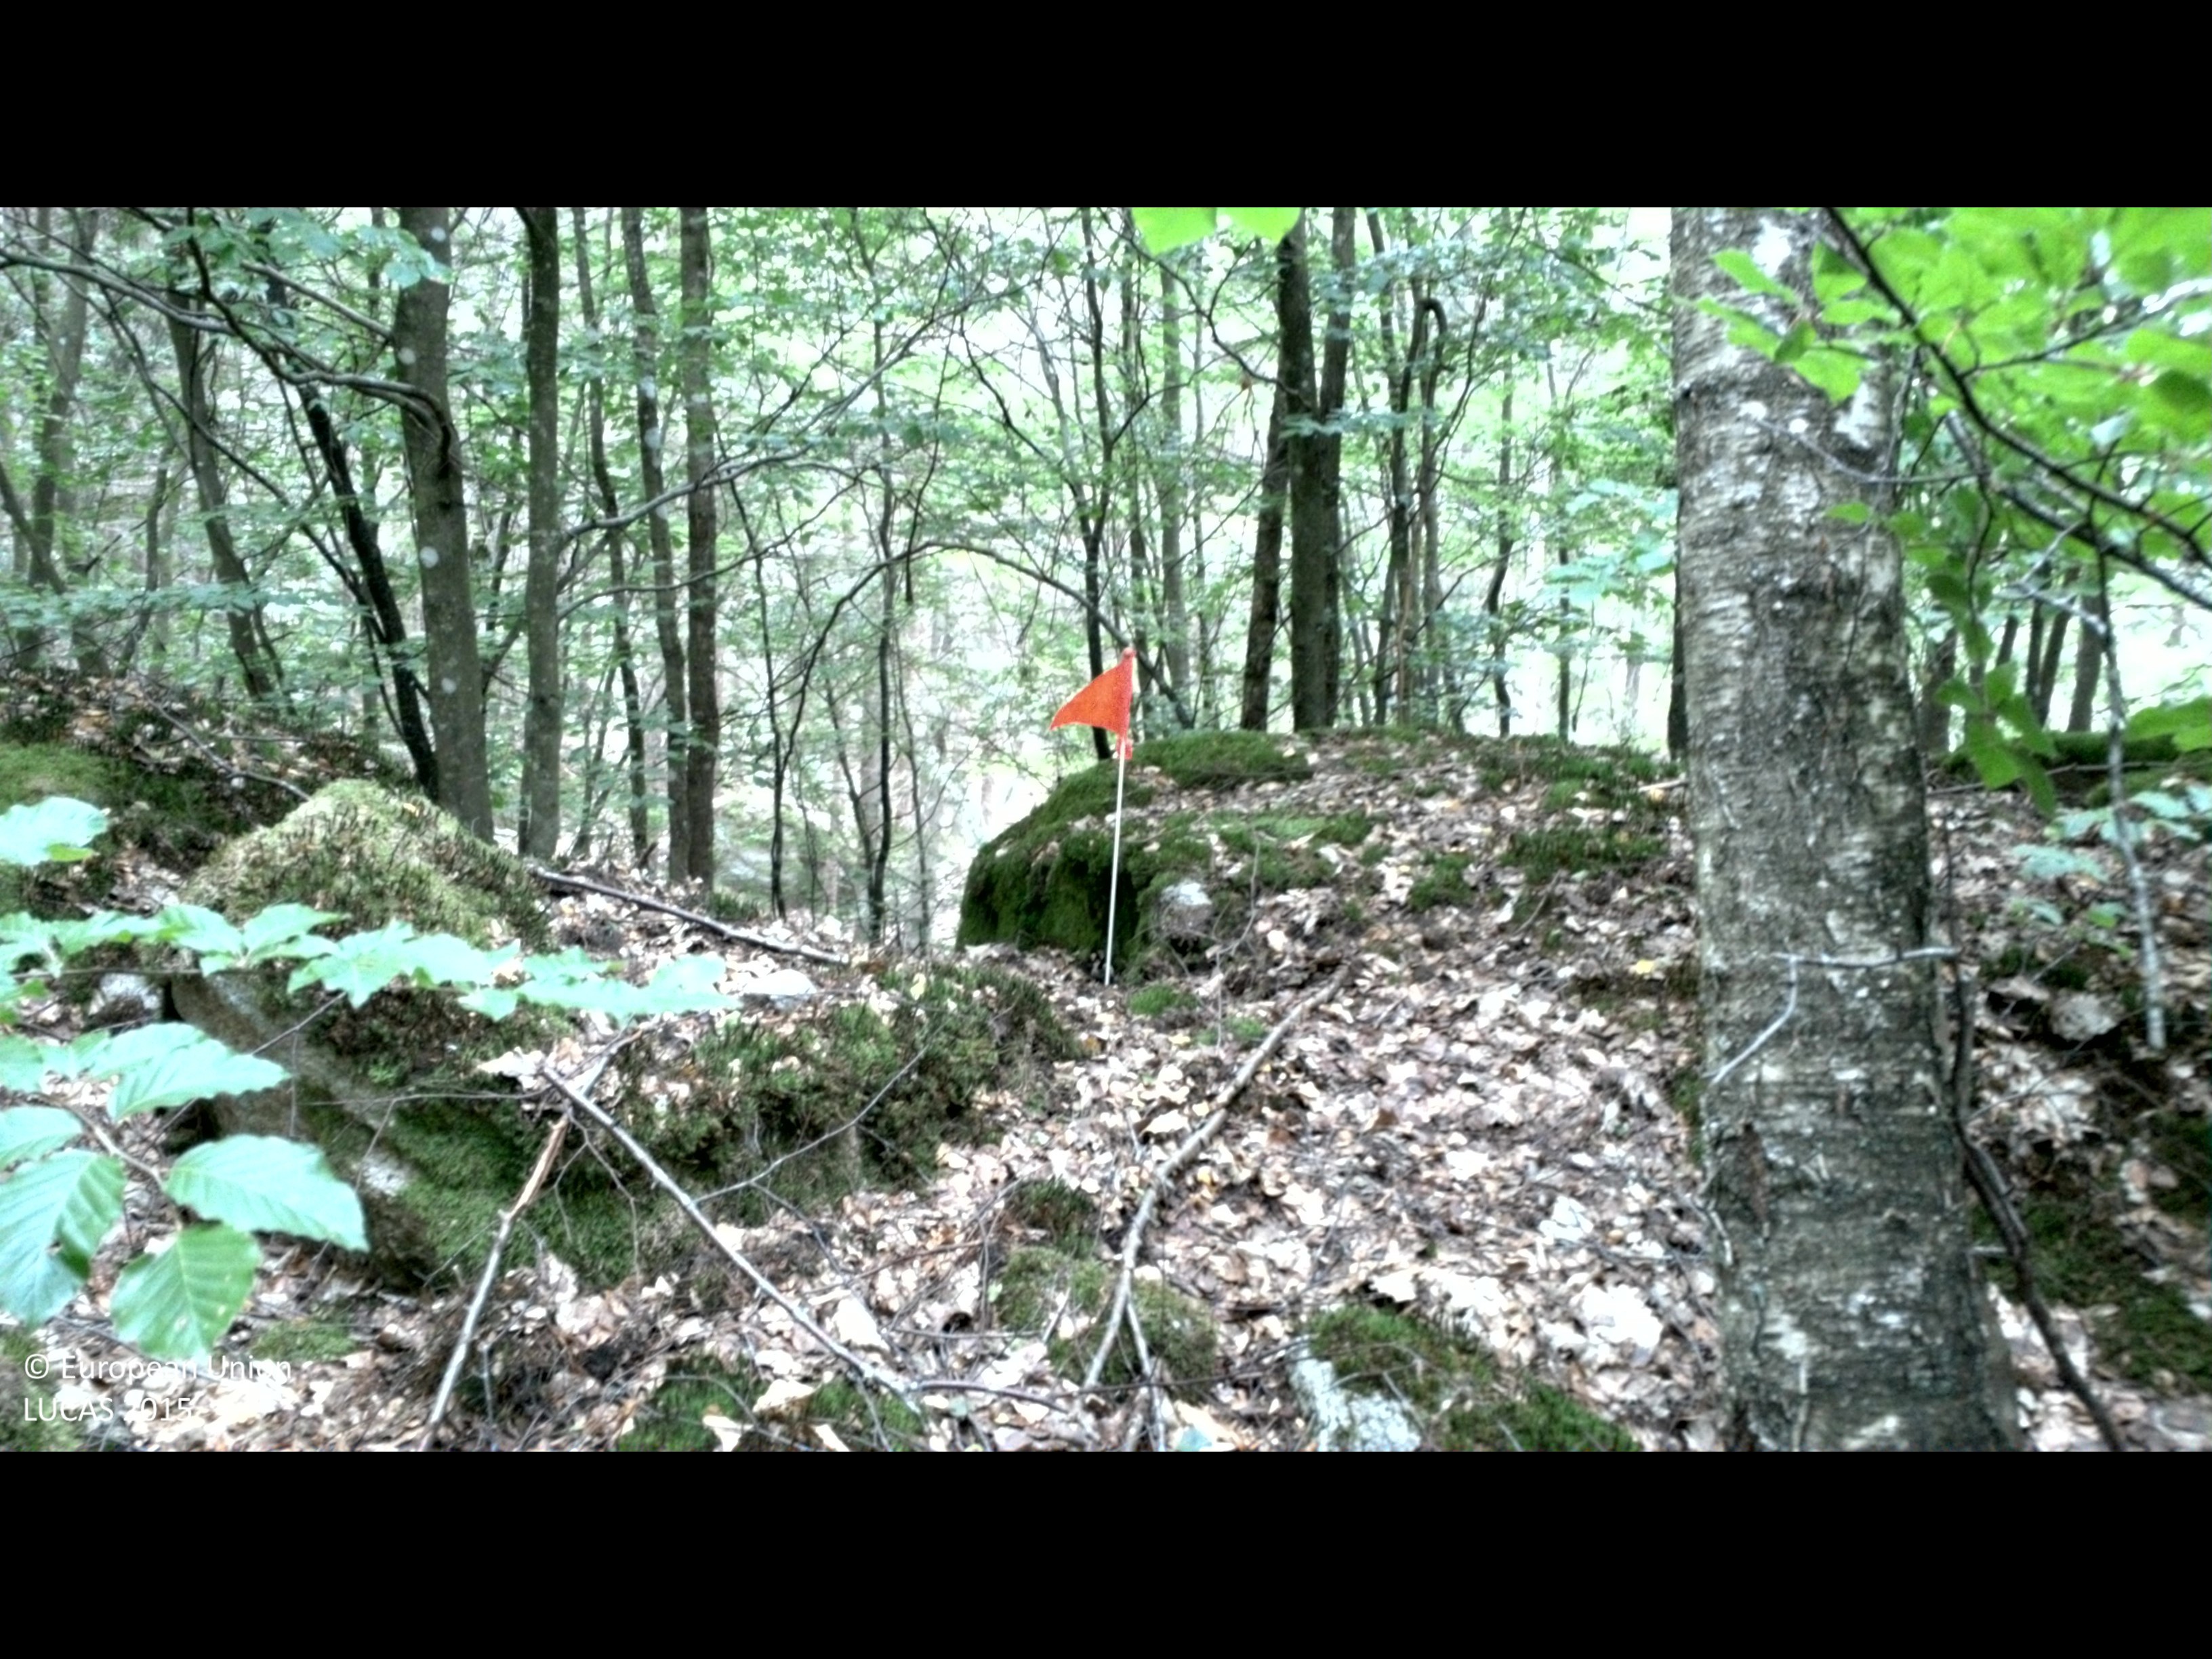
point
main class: Woodland
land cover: Broadleaved woodland
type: beech forest
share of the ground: > 75 %
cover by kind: broadleaved forest trees 90 %, lichens and mosses 5 %
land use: Forestry
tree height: > 5 m
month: July
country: SE
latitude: 56.2926
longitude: 15.3471
